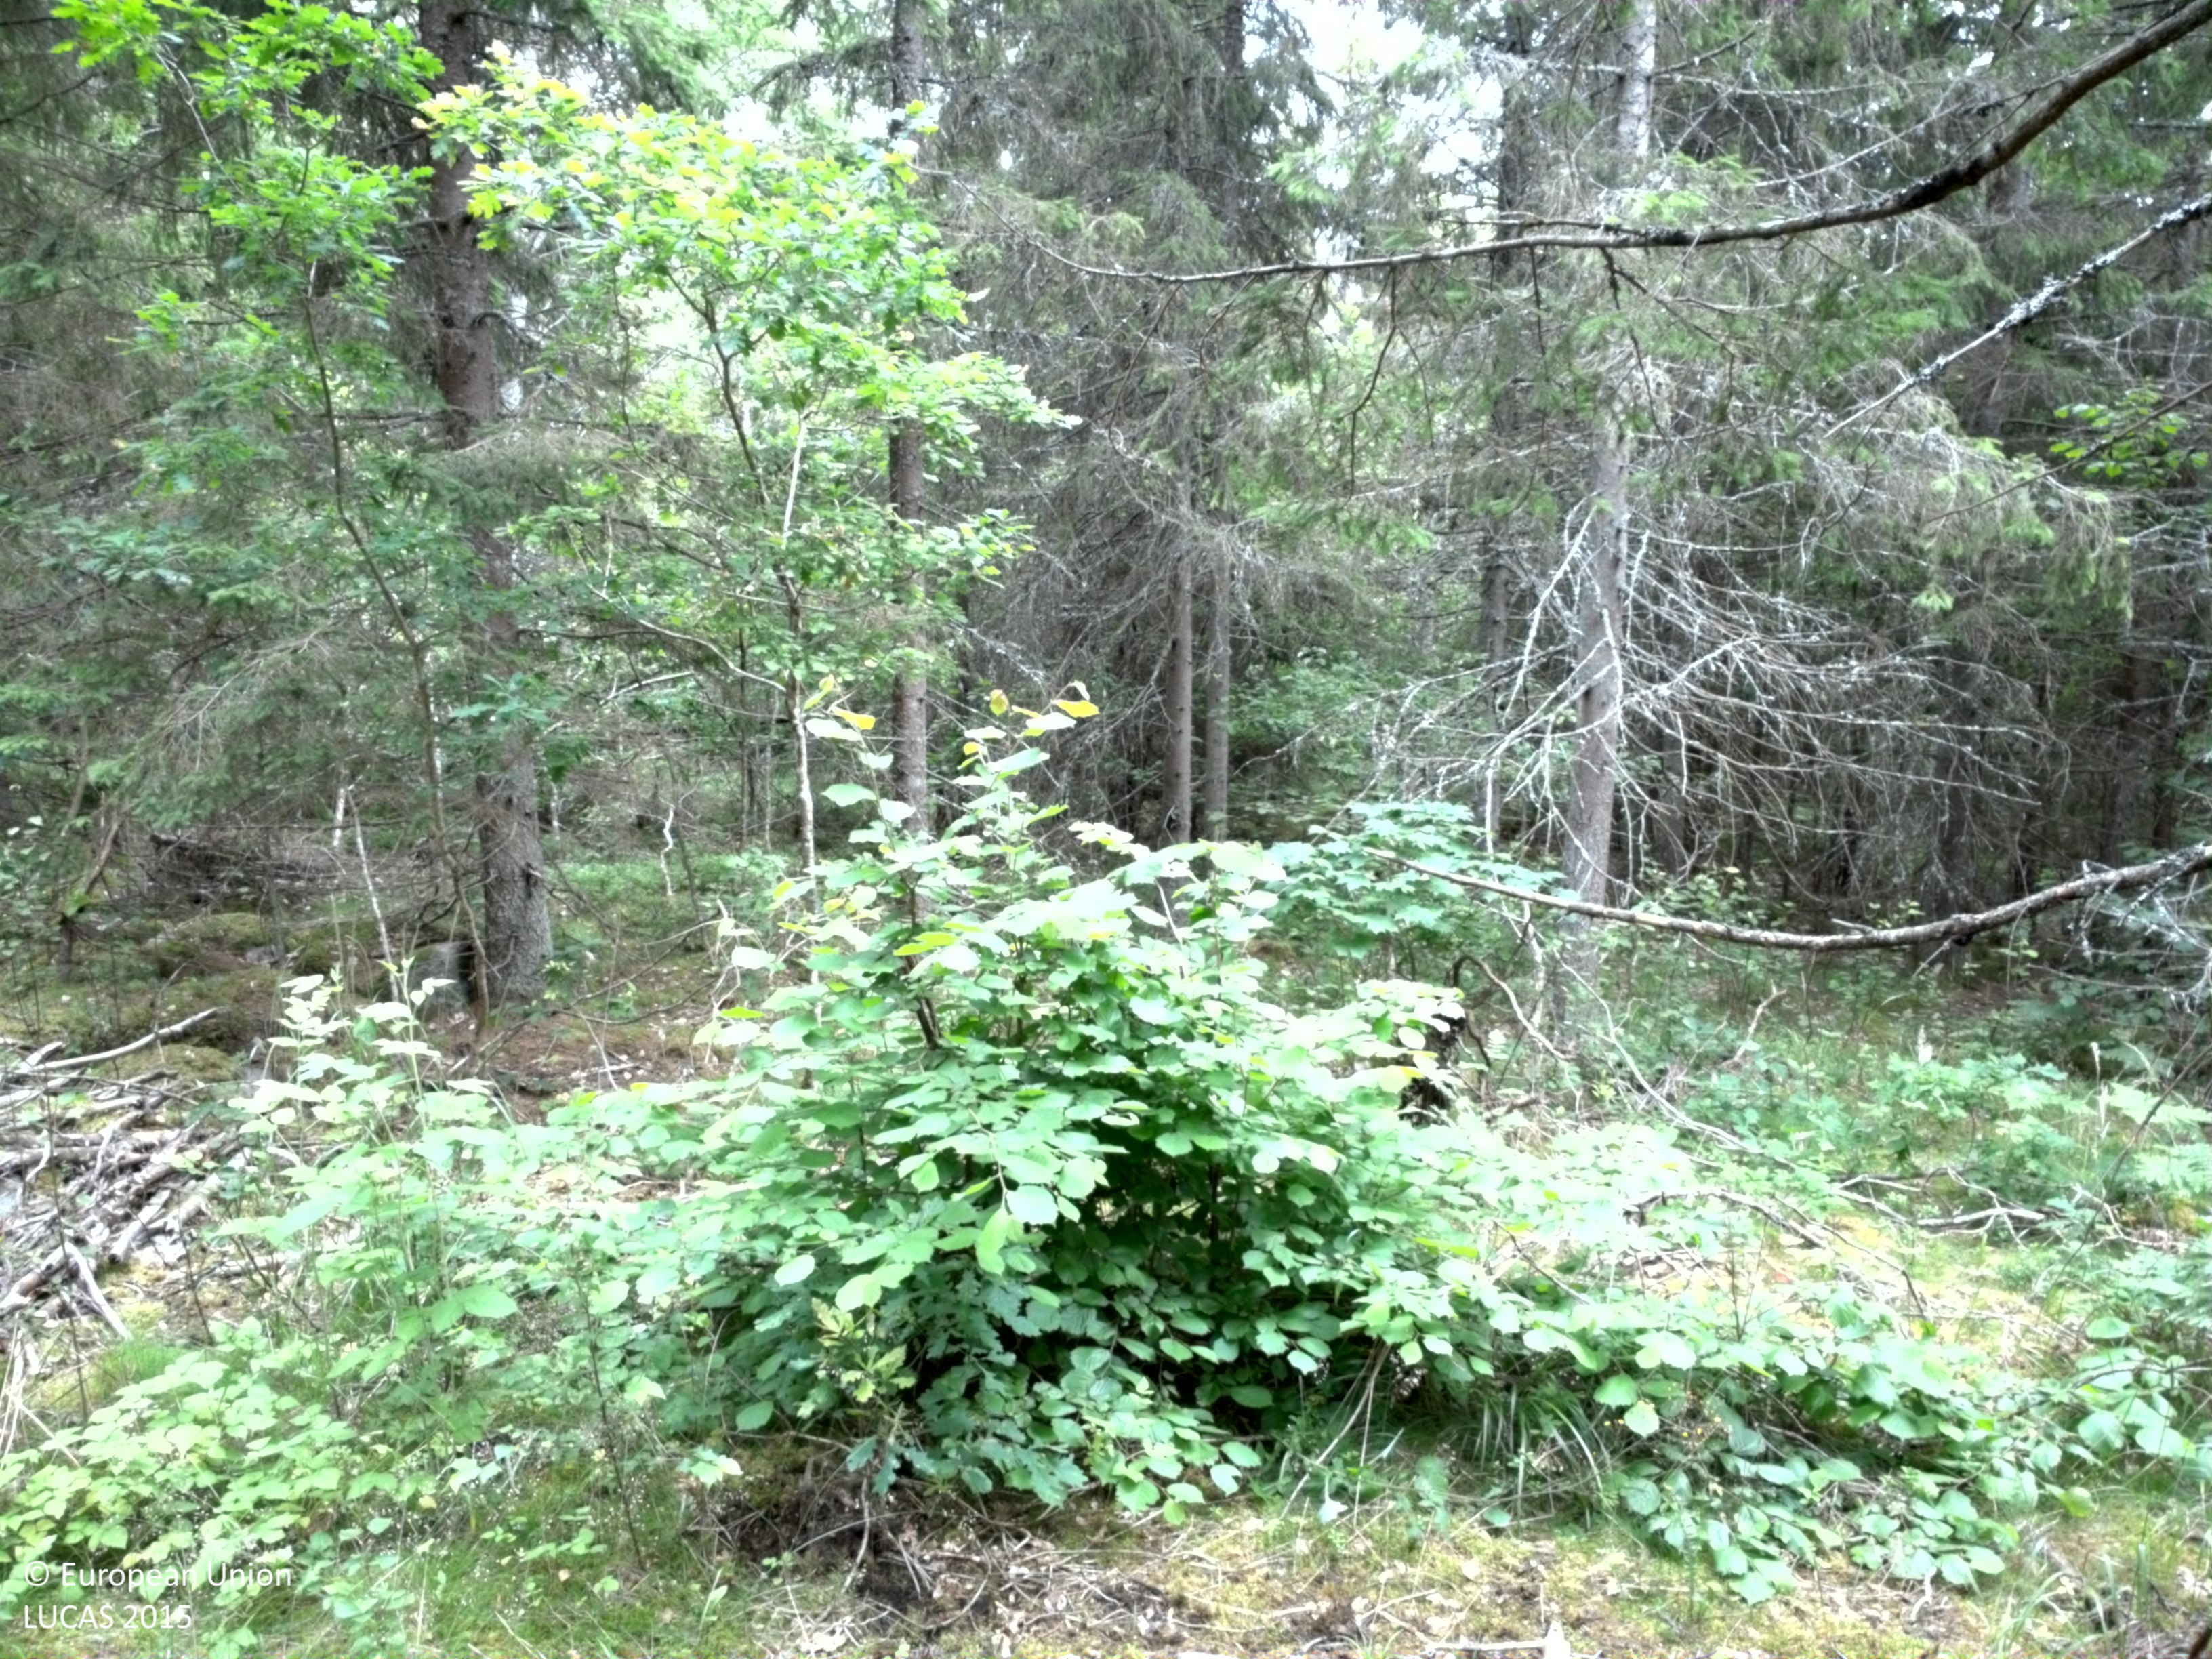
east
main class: Woodland
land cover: Spruce dominated coniferous woodland
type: boreal forest
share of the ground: > 75 %
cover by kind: coniferous forest trees 70 %, broadleaved forest trees 15 %, lichens and mosses 15 %
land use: Forestry
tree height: > 5 m
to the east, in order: Spruce dominated coniferous woodland; Spruce dominated mixed woodland; Broadleaved woodland; Ditches and canals; Broadleaved woodland; Grassland without tree/shrub cover; Broadleaved woodland
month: July
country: SE
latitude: 59.8128
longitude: 18.5391
